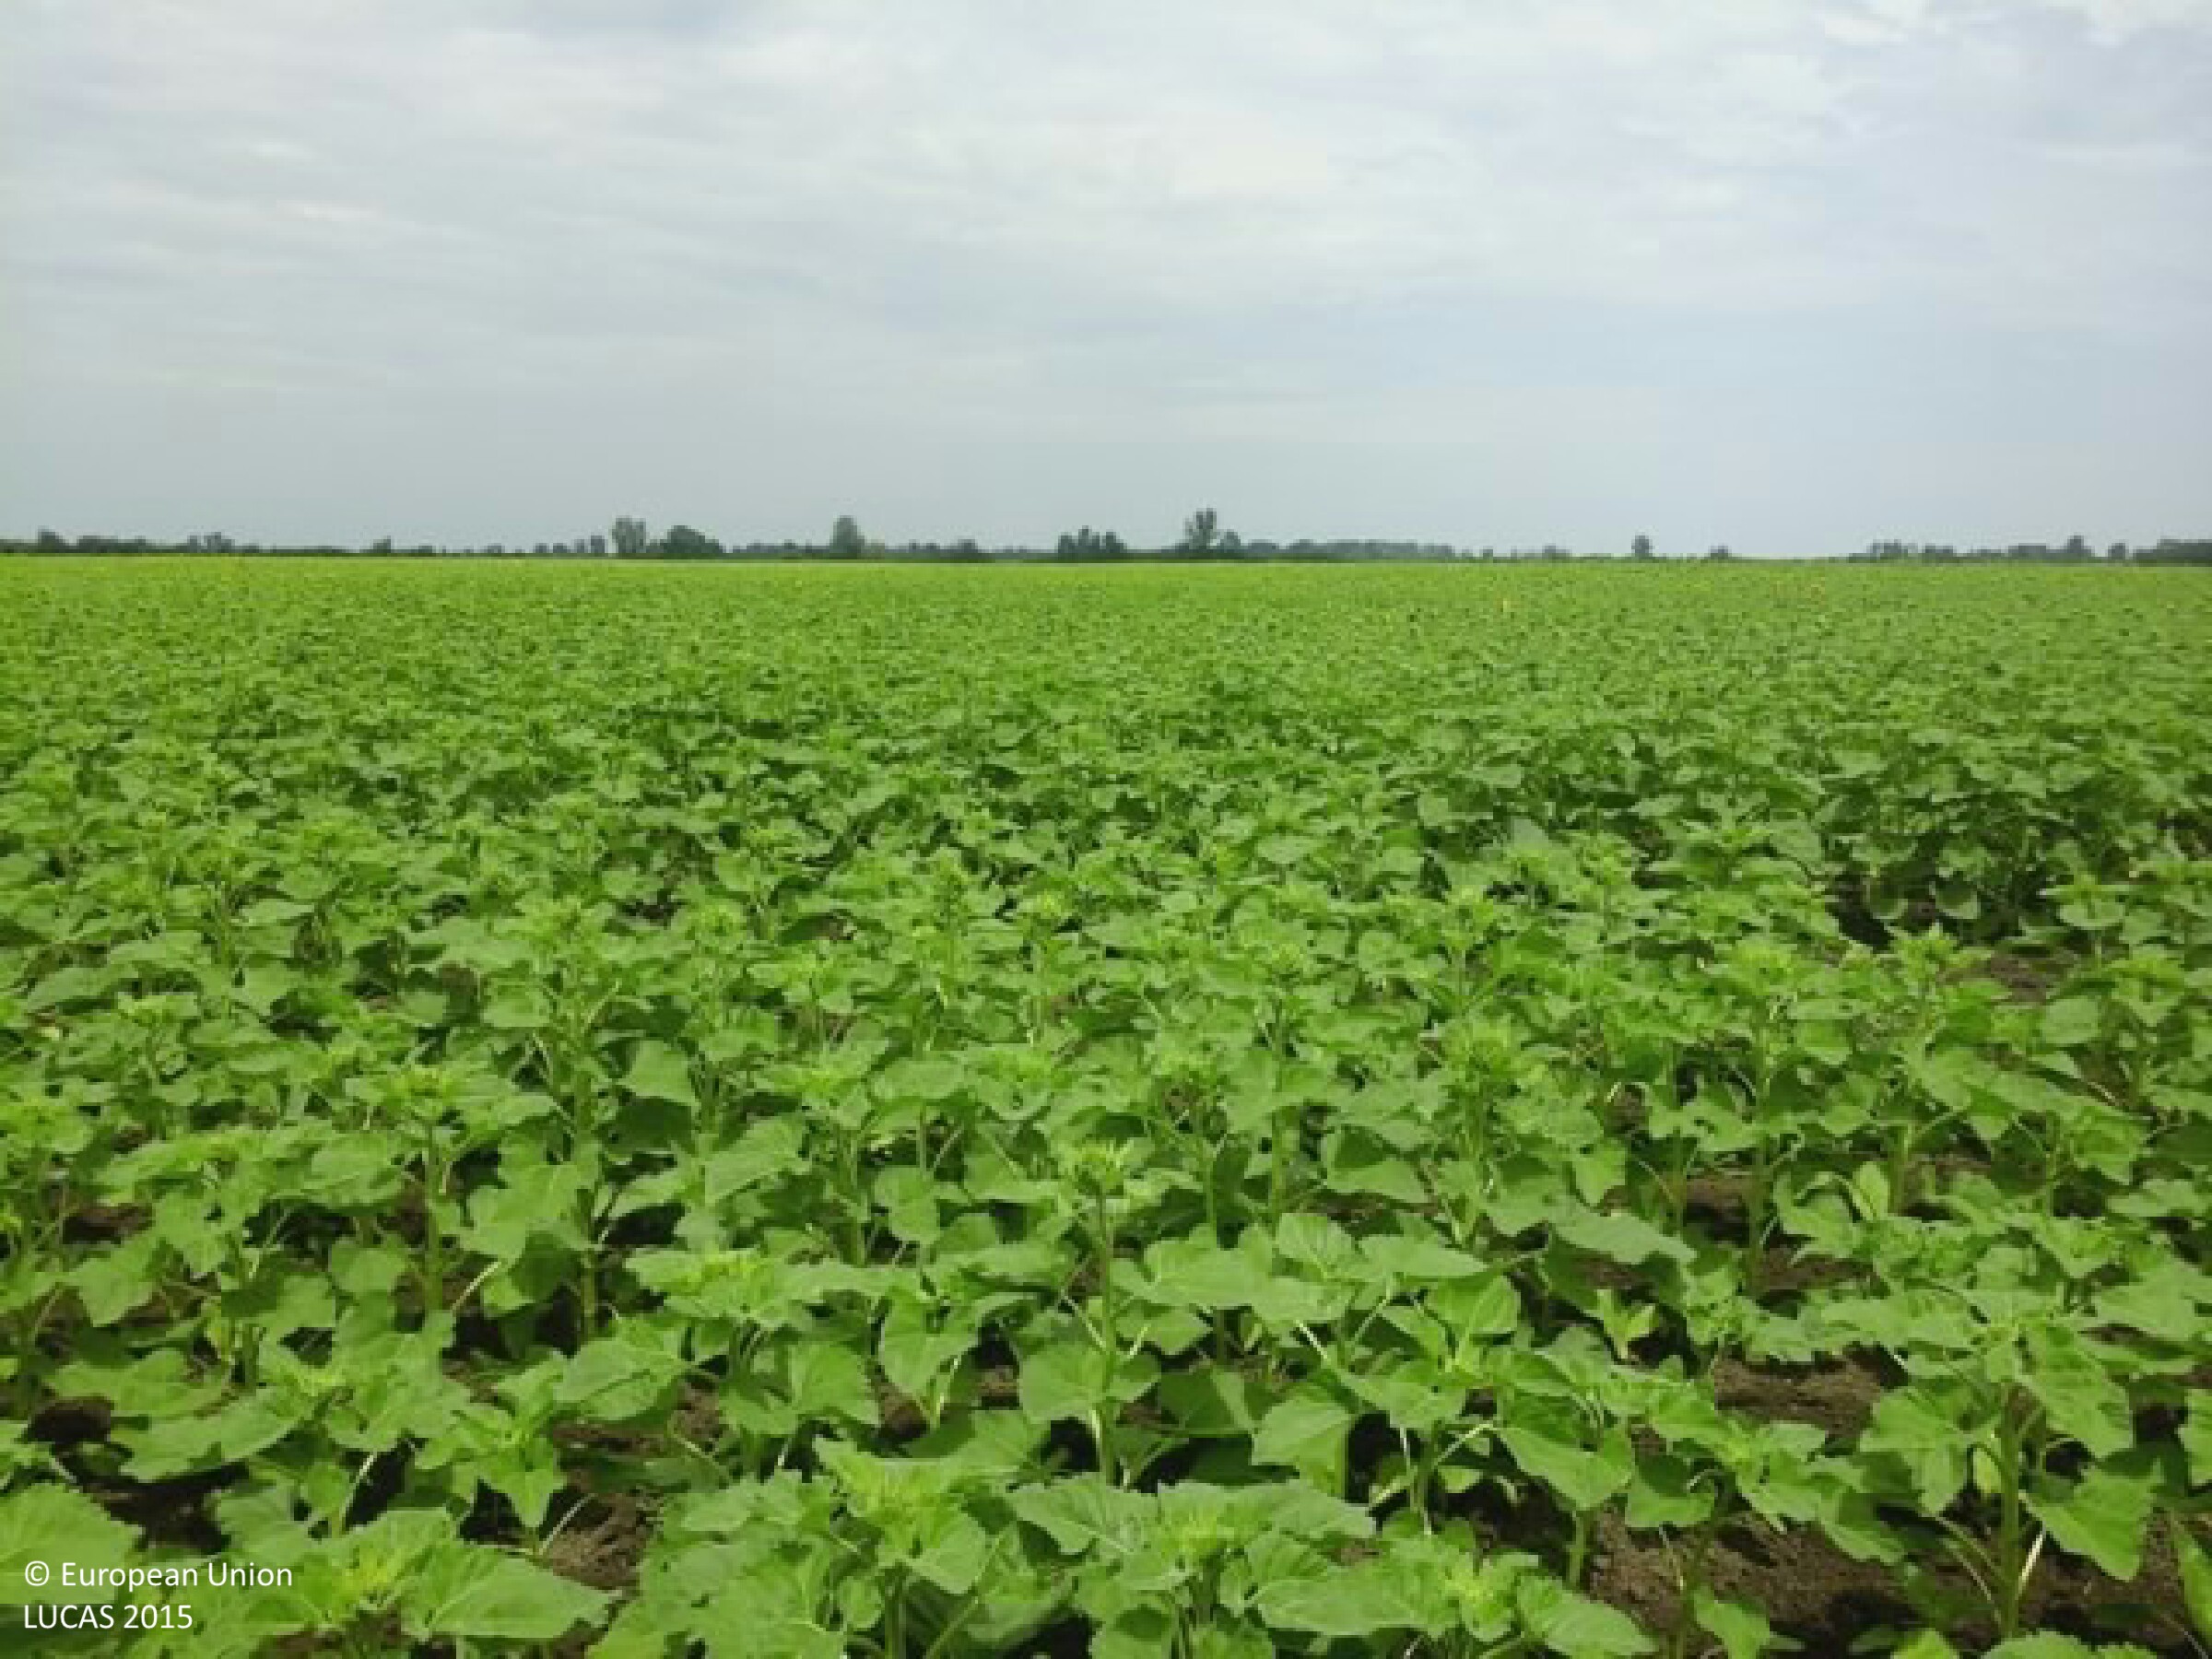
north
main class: Cropland
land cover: Sunflower
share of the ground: > 75 %
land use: Agriculture (excluding fallow land and kitchen gardens)
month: June
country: HU
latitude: 46.6118
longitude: 20.1427
